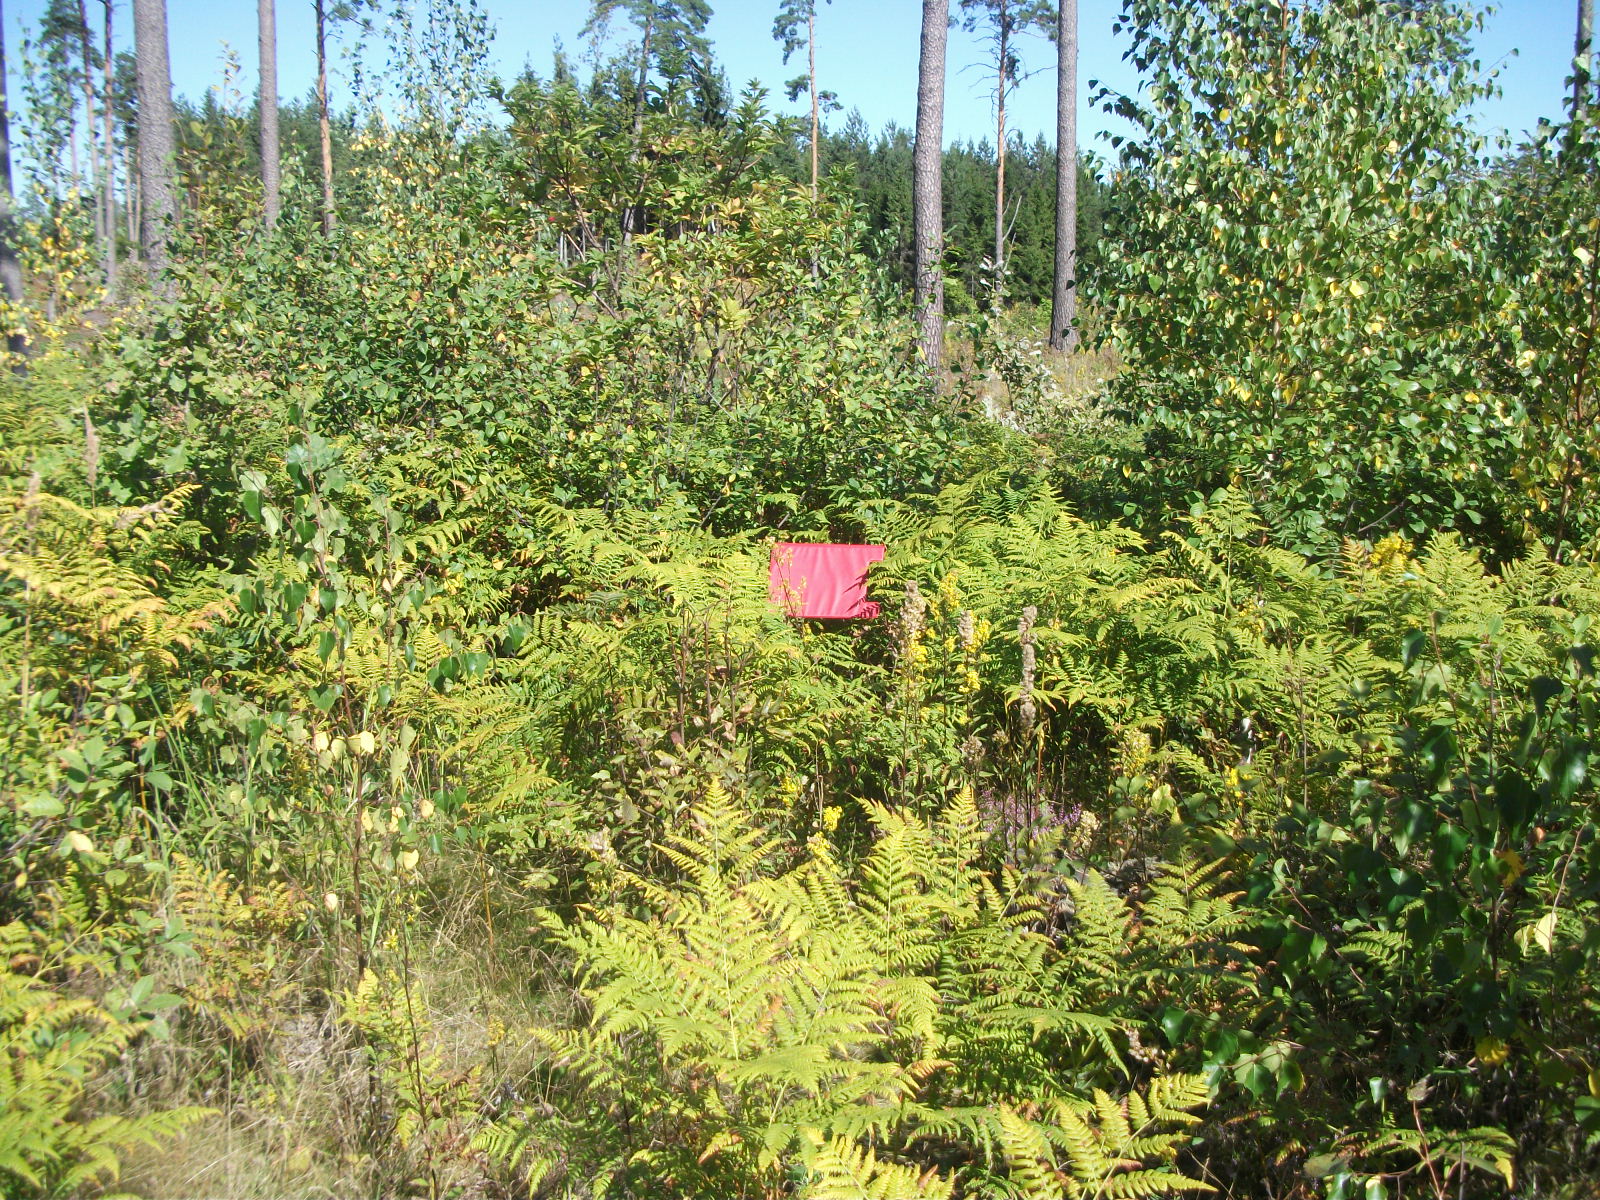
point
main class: Woodland
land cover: Broadleaved woodland
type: non-riverine alder, birch or aspen forest
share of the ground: 50 - 75 %
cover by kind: broadleaved forest trees 50 %, shrubs 30 %, herbaceous plants 15 %, coniferous forest trees 5 %
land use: Forestry
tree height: < 5 m
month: August
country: LV
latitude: 56.4888
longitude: 26.0674
